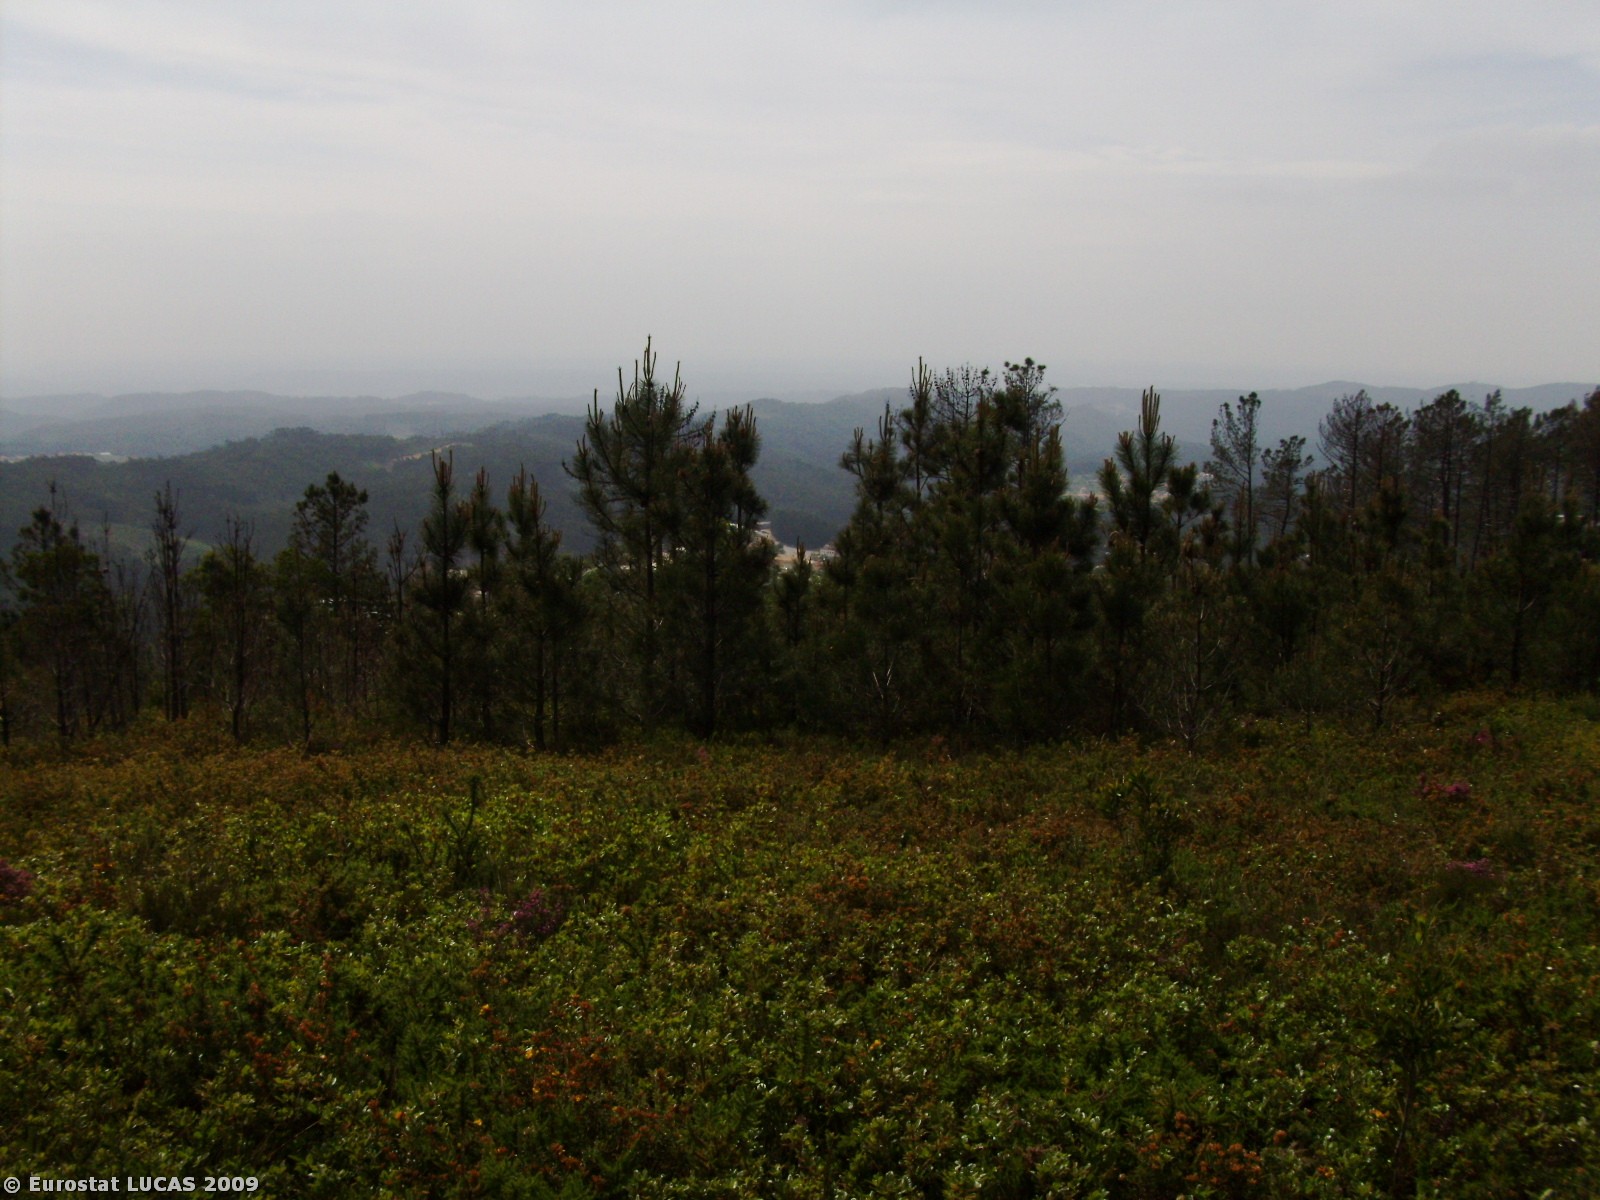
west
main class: Shrubland
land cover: Shrubland without tree cover
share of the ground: > 75 %
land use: Amenities, museums, leisure
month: May
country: PT
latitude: 40.3033
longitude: -8.3065
